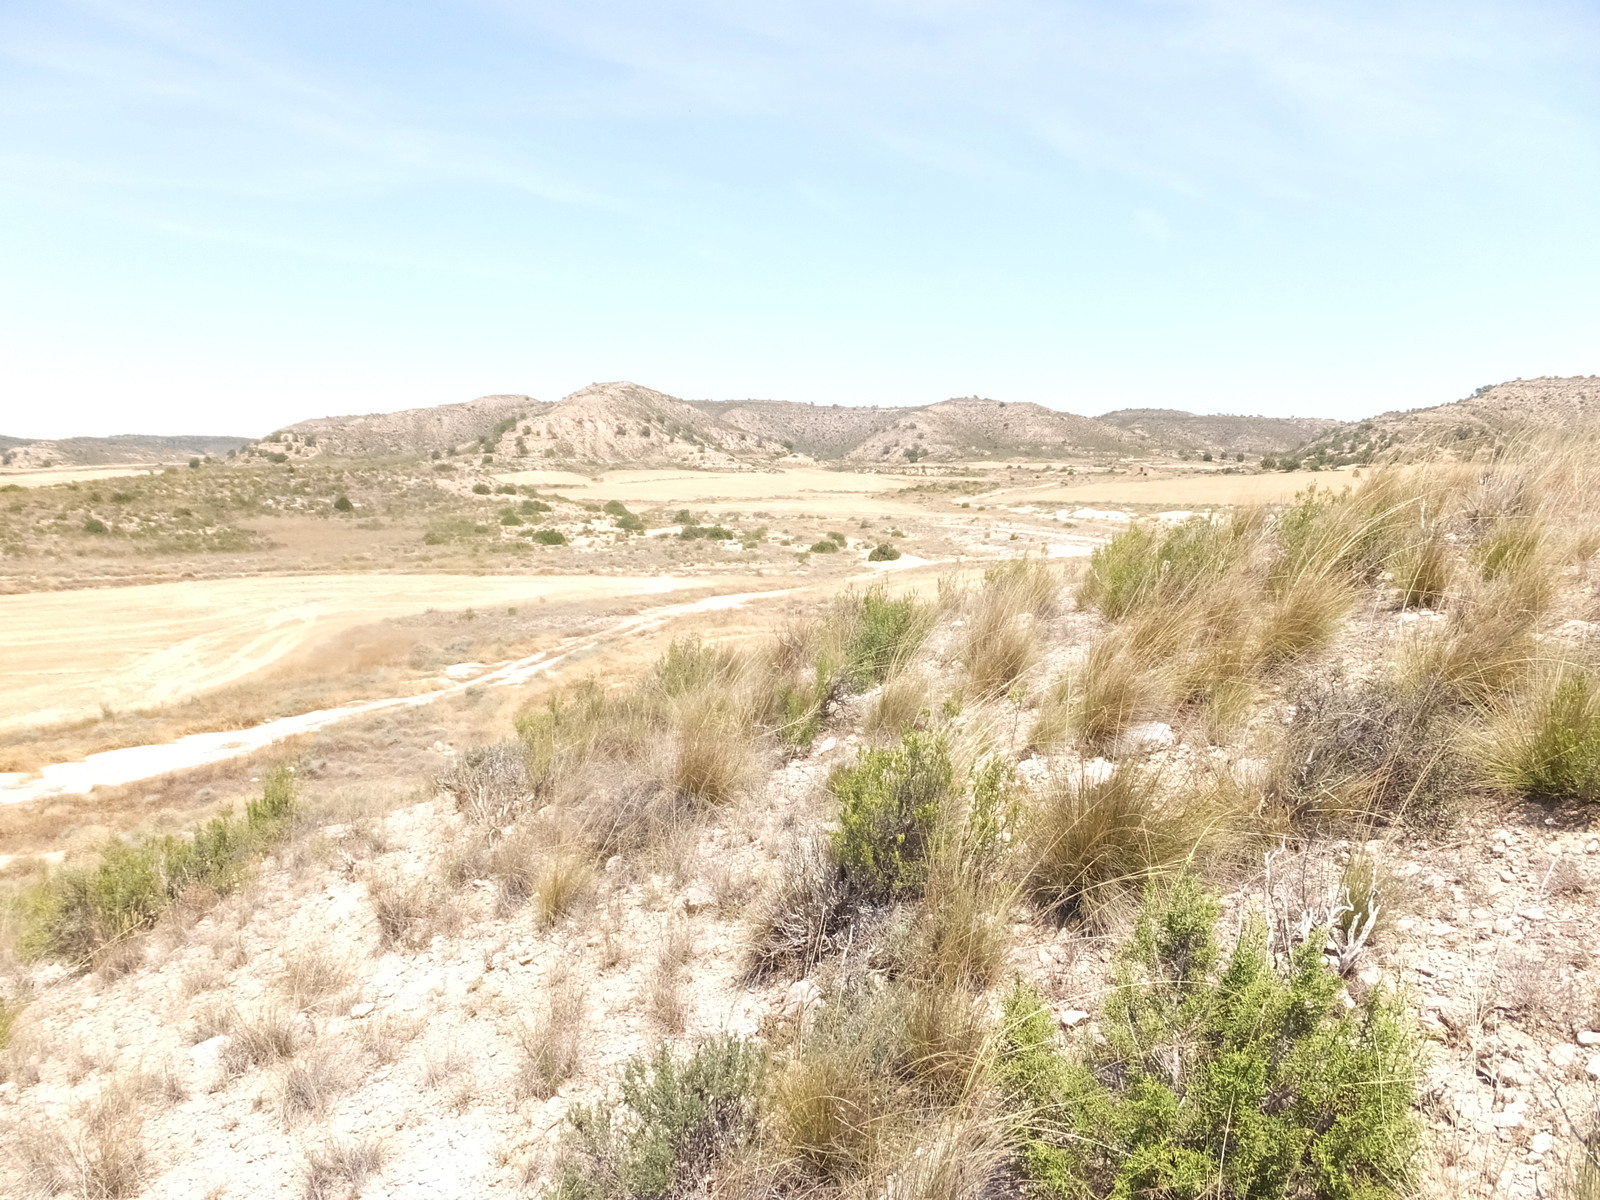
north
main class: Shrubland
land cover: Shrubland without tree cover
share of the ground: > 75 %
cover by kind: shrubs 40 %, herbaceous plants 40 %, consolidated bare surface 20 %
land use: Semi-natural and natural areas not in use
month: June
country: ES
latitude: 41.3258
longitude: -0.1334
